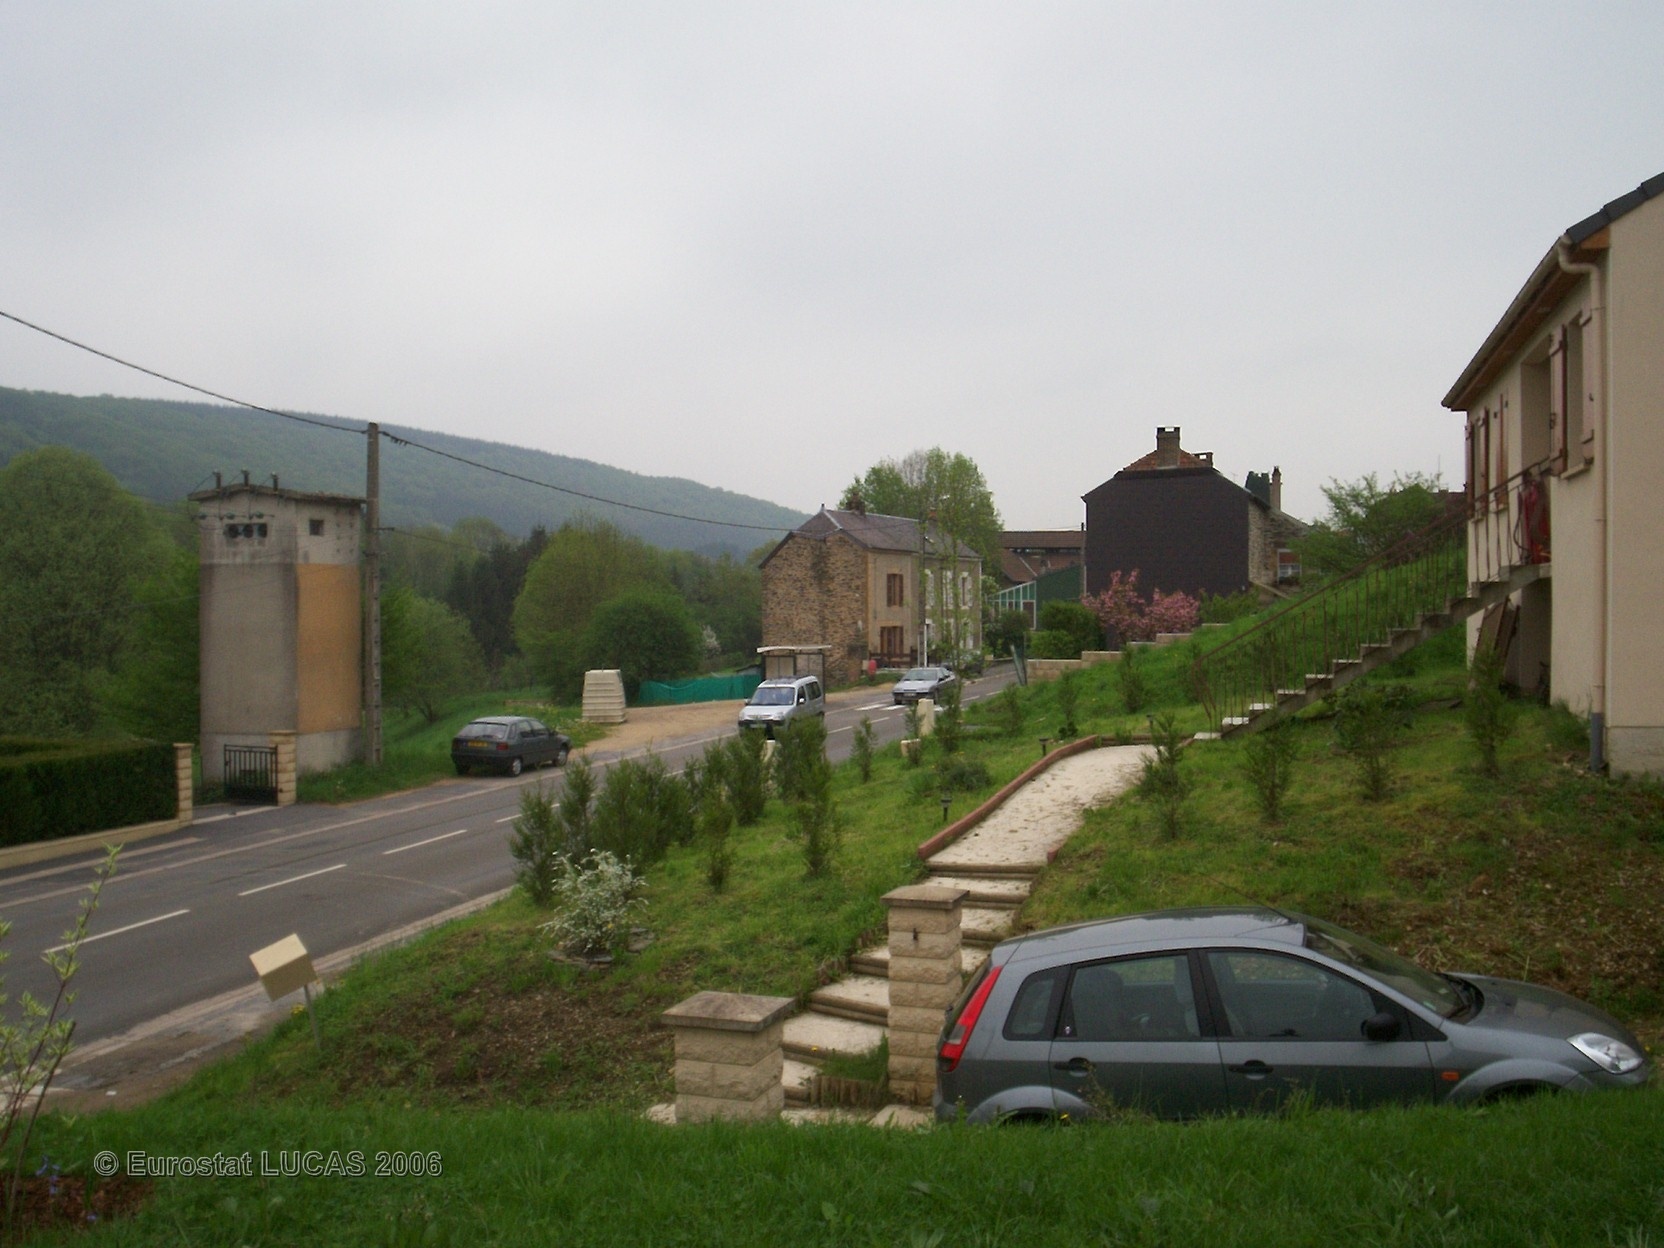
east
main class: Grassland
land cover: Grassland without tree/shrub cover
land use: Residential
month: May
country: FR
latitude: 49.8127
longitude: 4.7855
